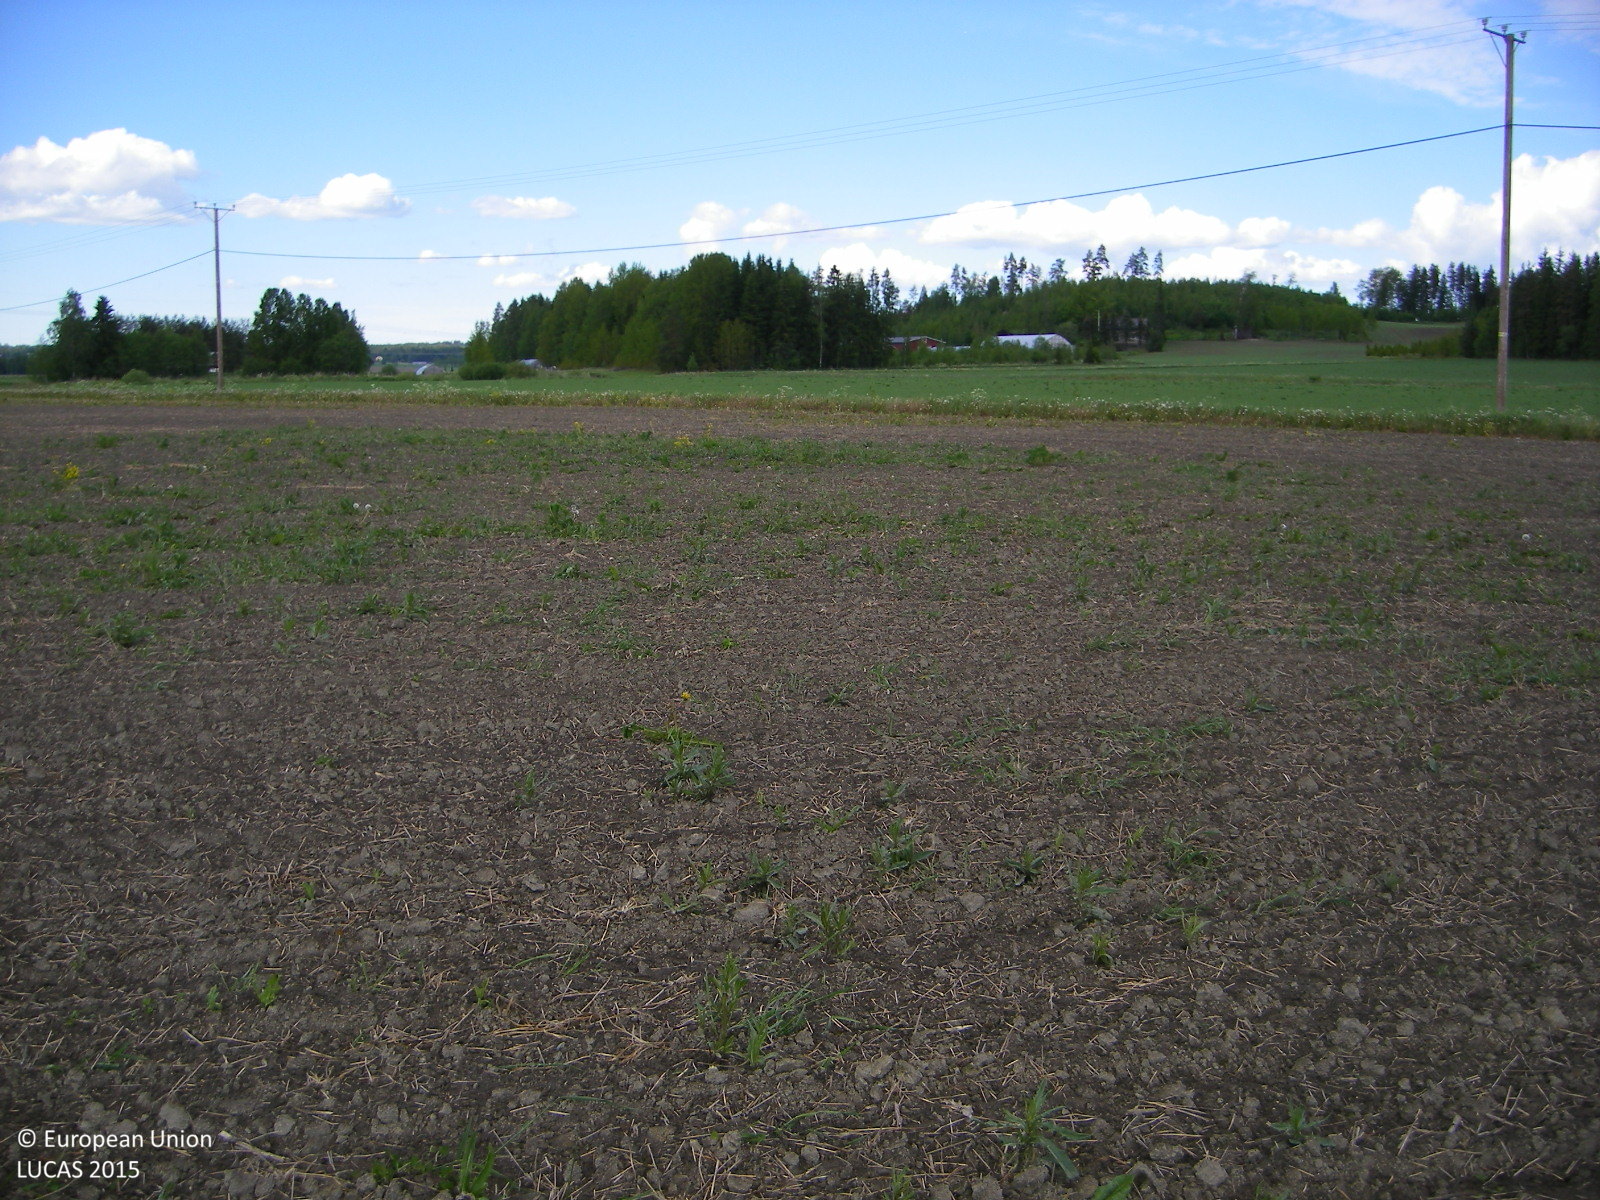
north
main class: Cropland
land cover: Common wheat
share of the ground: 10 - 25 %
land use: Agriculture (excluding fallow land and kitchen gardens)
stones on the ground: < 10 %
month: June
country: FI
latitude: 60.4226
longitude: 24.6211
